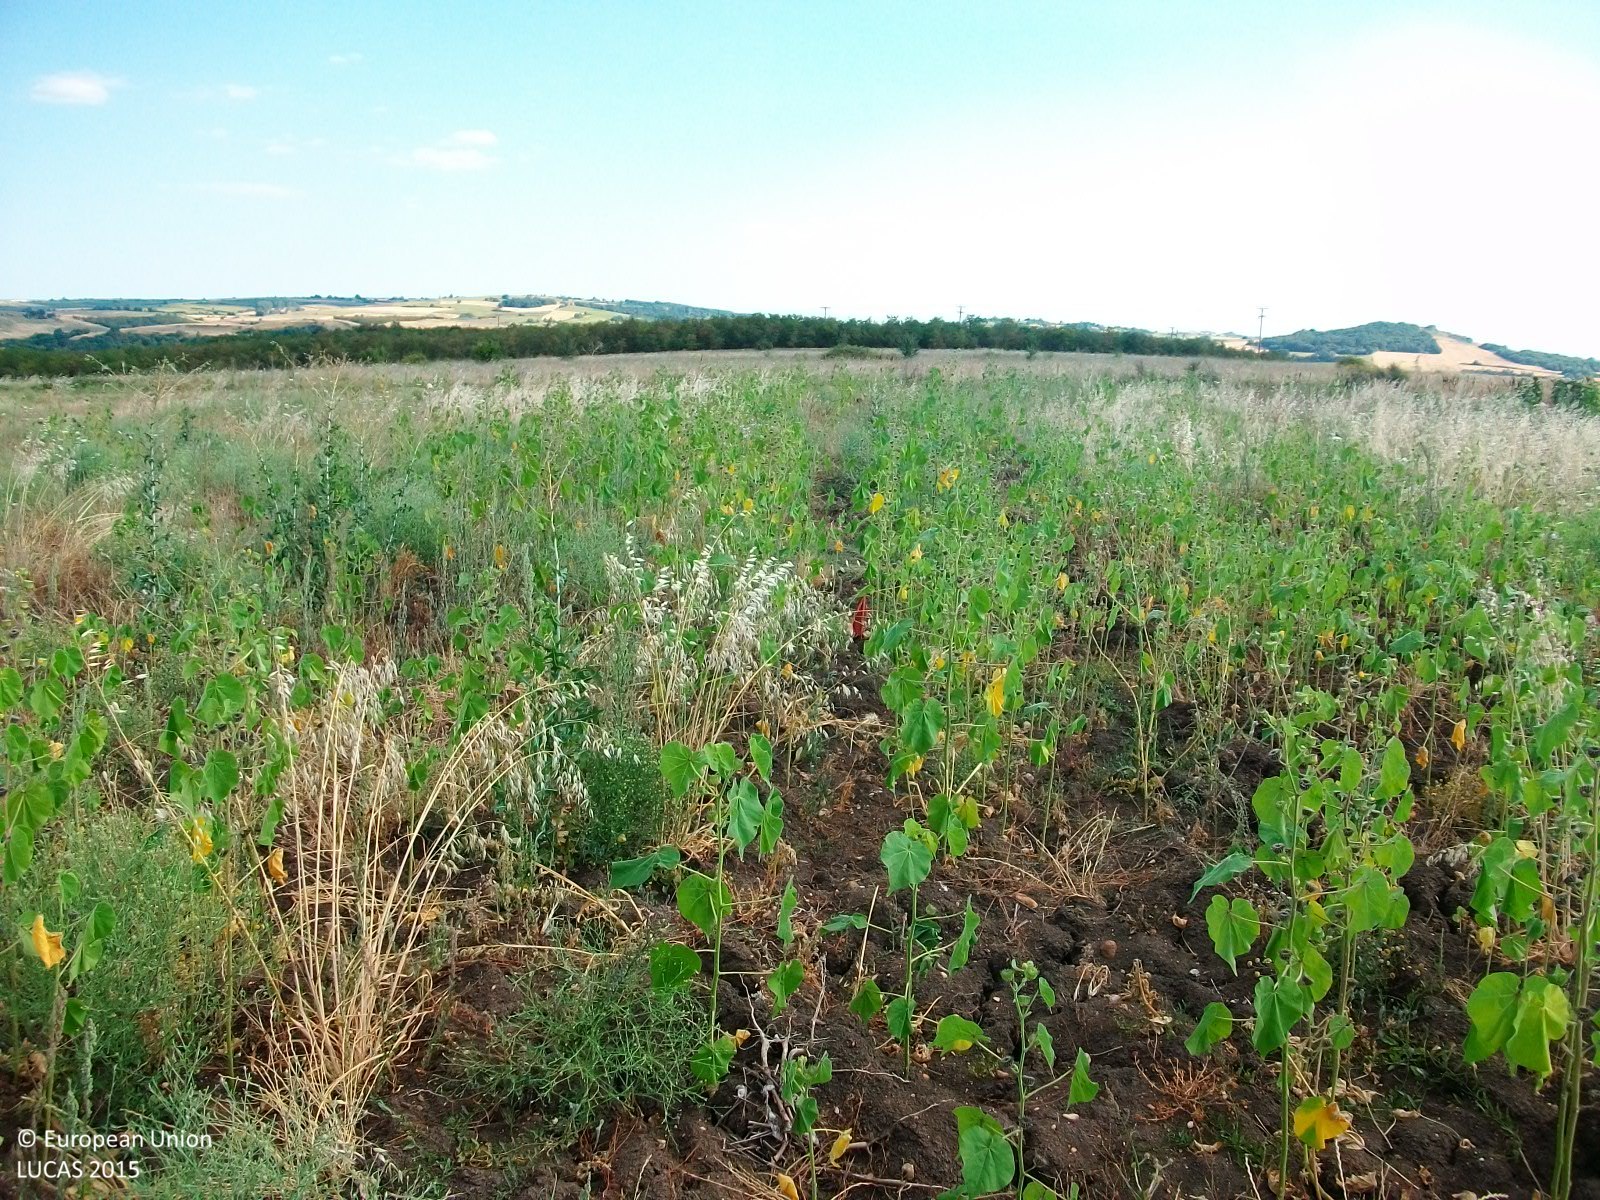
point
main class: Cropland
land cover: Sunflower
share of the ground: > 75 %
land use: Agriculture (excluding fallow land and kitchen gardens)
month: July
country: GR
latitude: 41.5586
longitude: 26.3224
